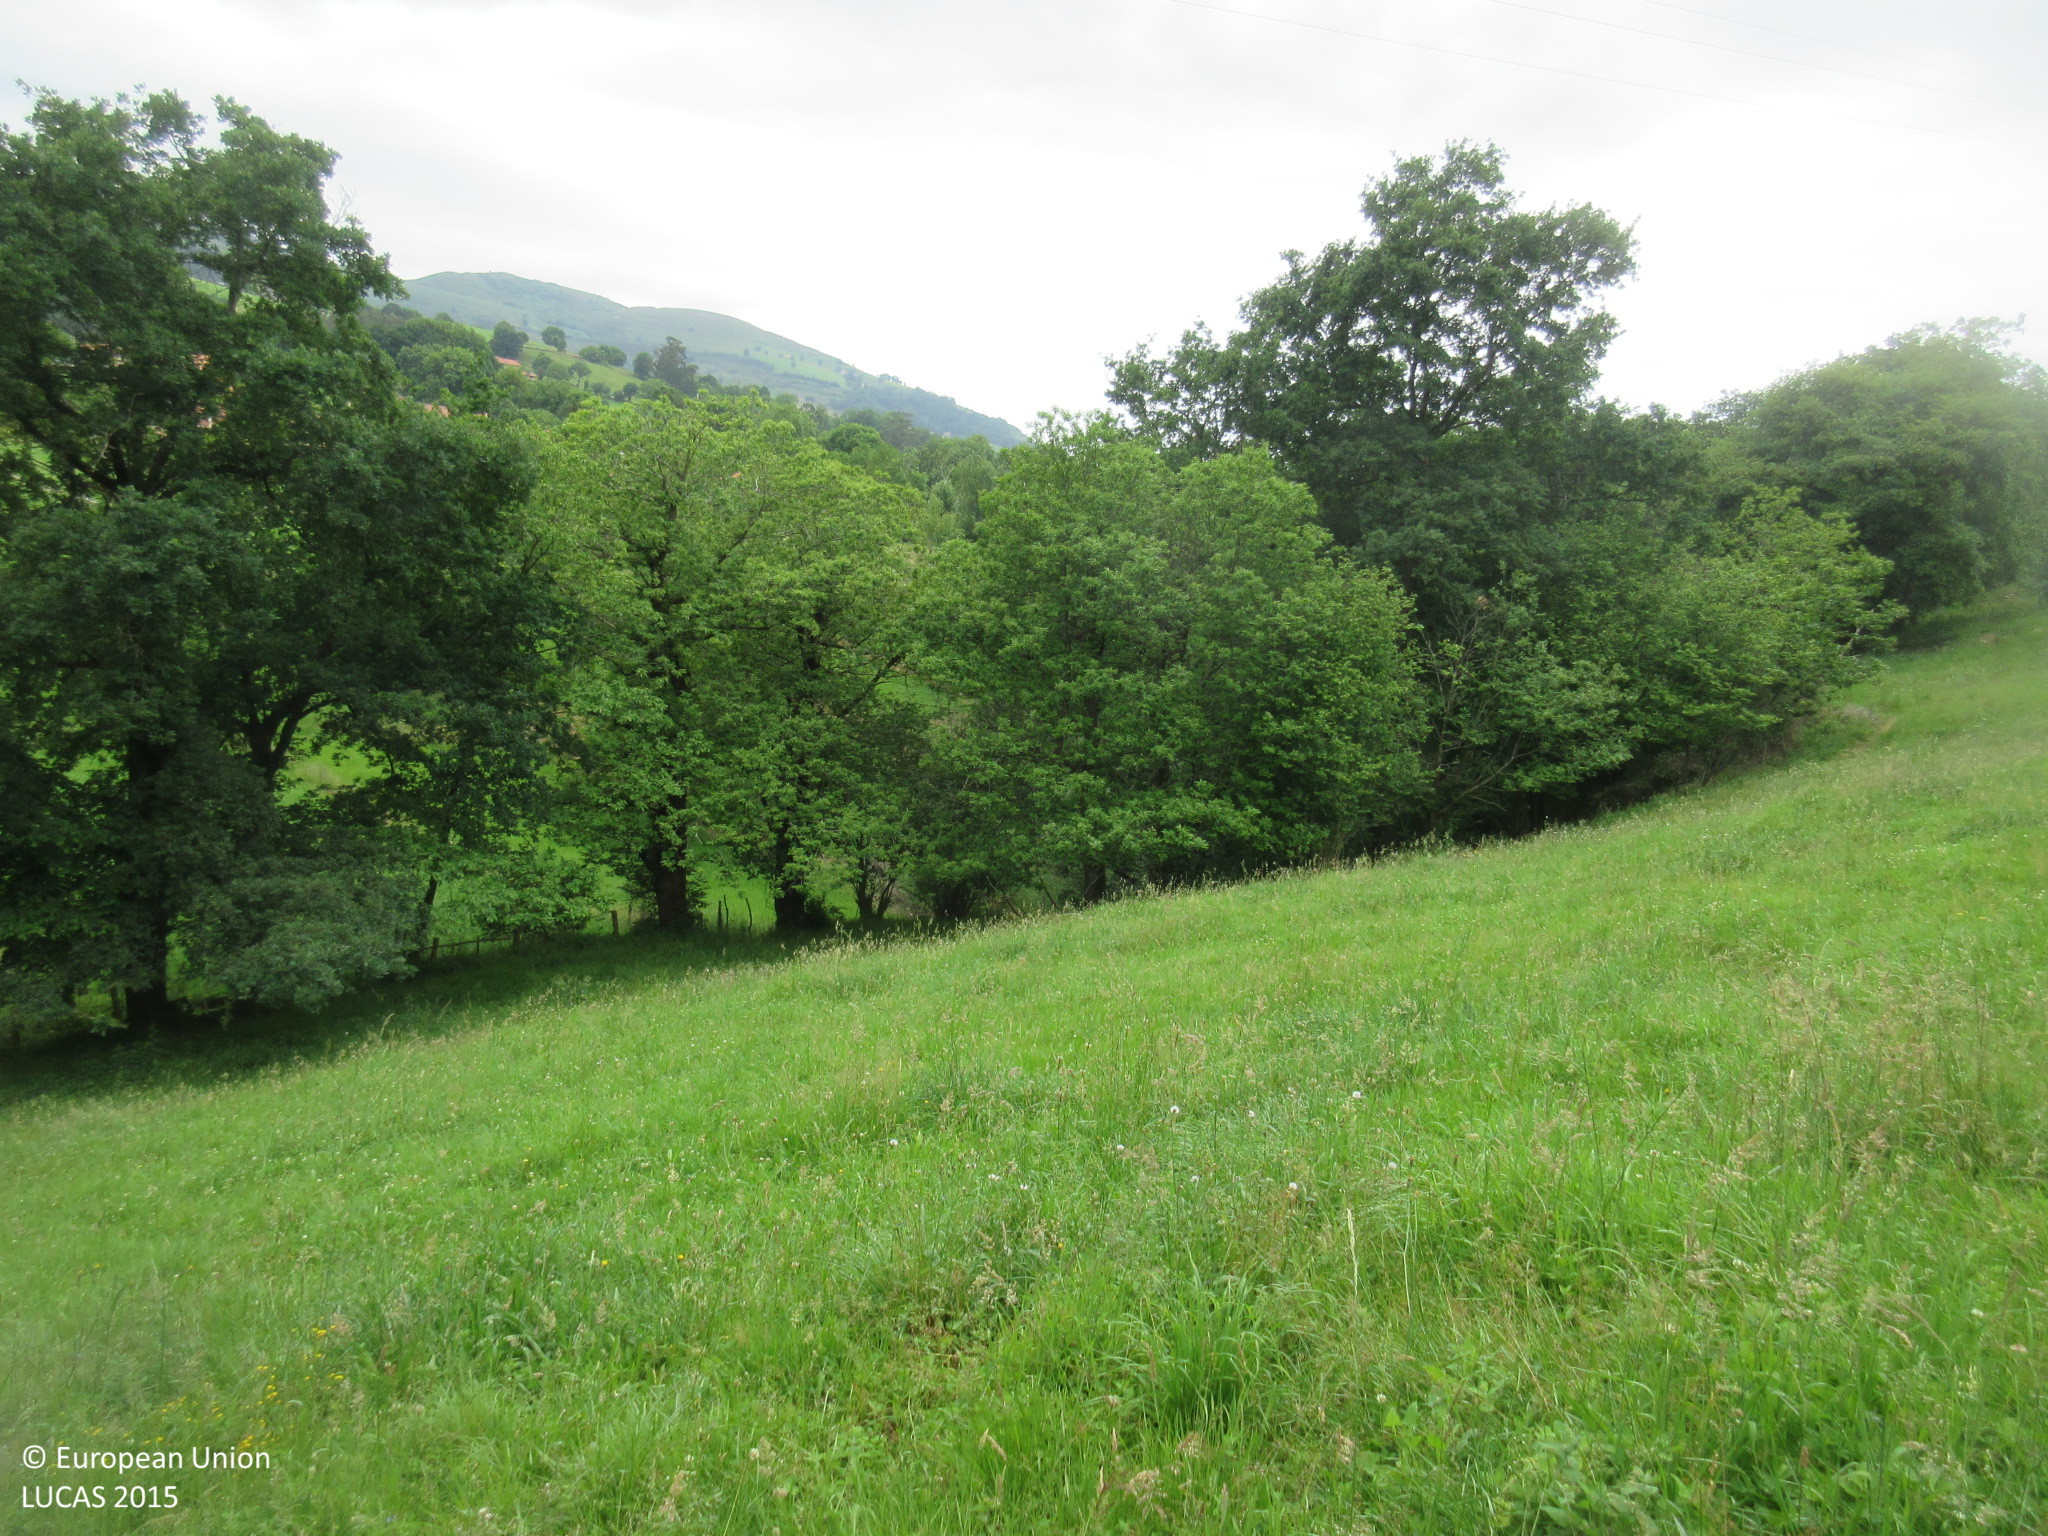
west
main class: Grassland
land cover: Grassland without tree/shrub cover
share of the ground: > 75 %
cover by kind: herbaceous plants 100 %
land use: Agriculture (excluding fallow land and kitchen gardens)
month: June
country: ES
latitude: 43.3583
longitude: -3.6052
